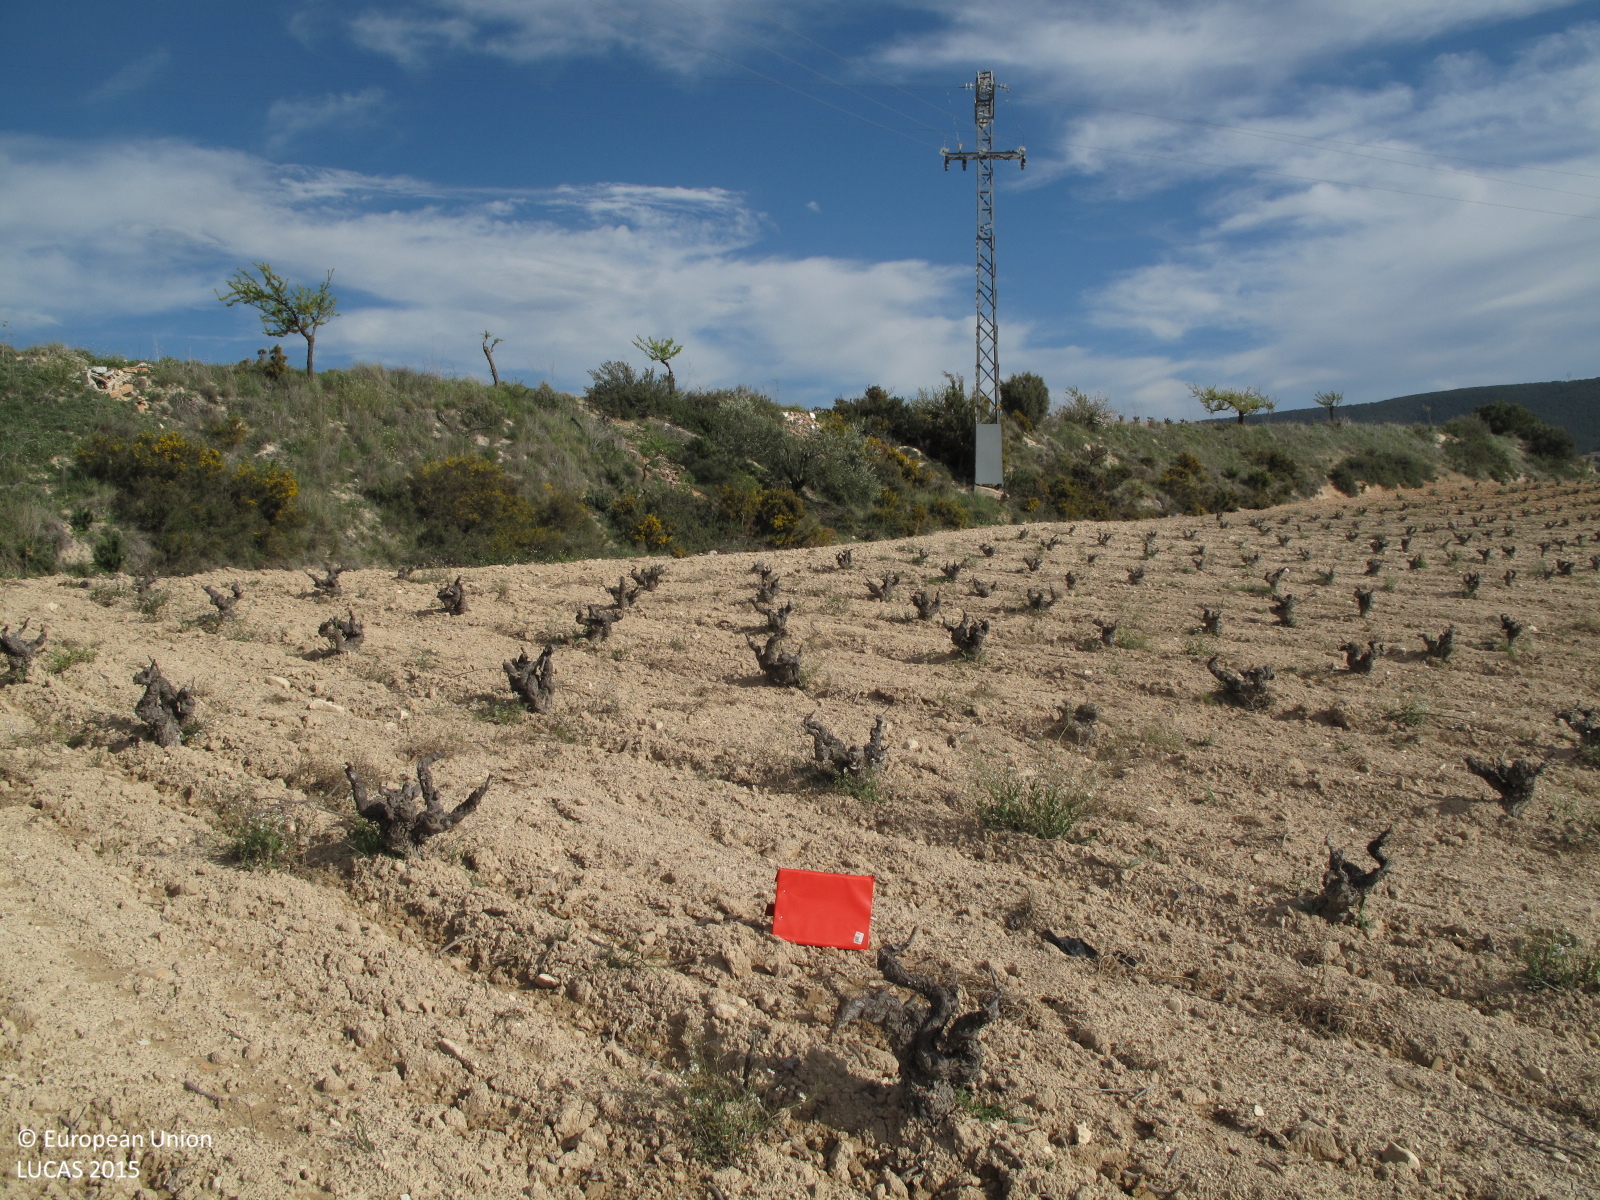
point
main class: Cropland
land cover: Vineyards
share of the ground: < 10 %
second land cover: Other bare soil
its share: > 75 %
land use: Agriculture (excluding fallow land and kitchen gardens)
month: March
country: ES
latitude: 38.7956
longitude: -0.7800
